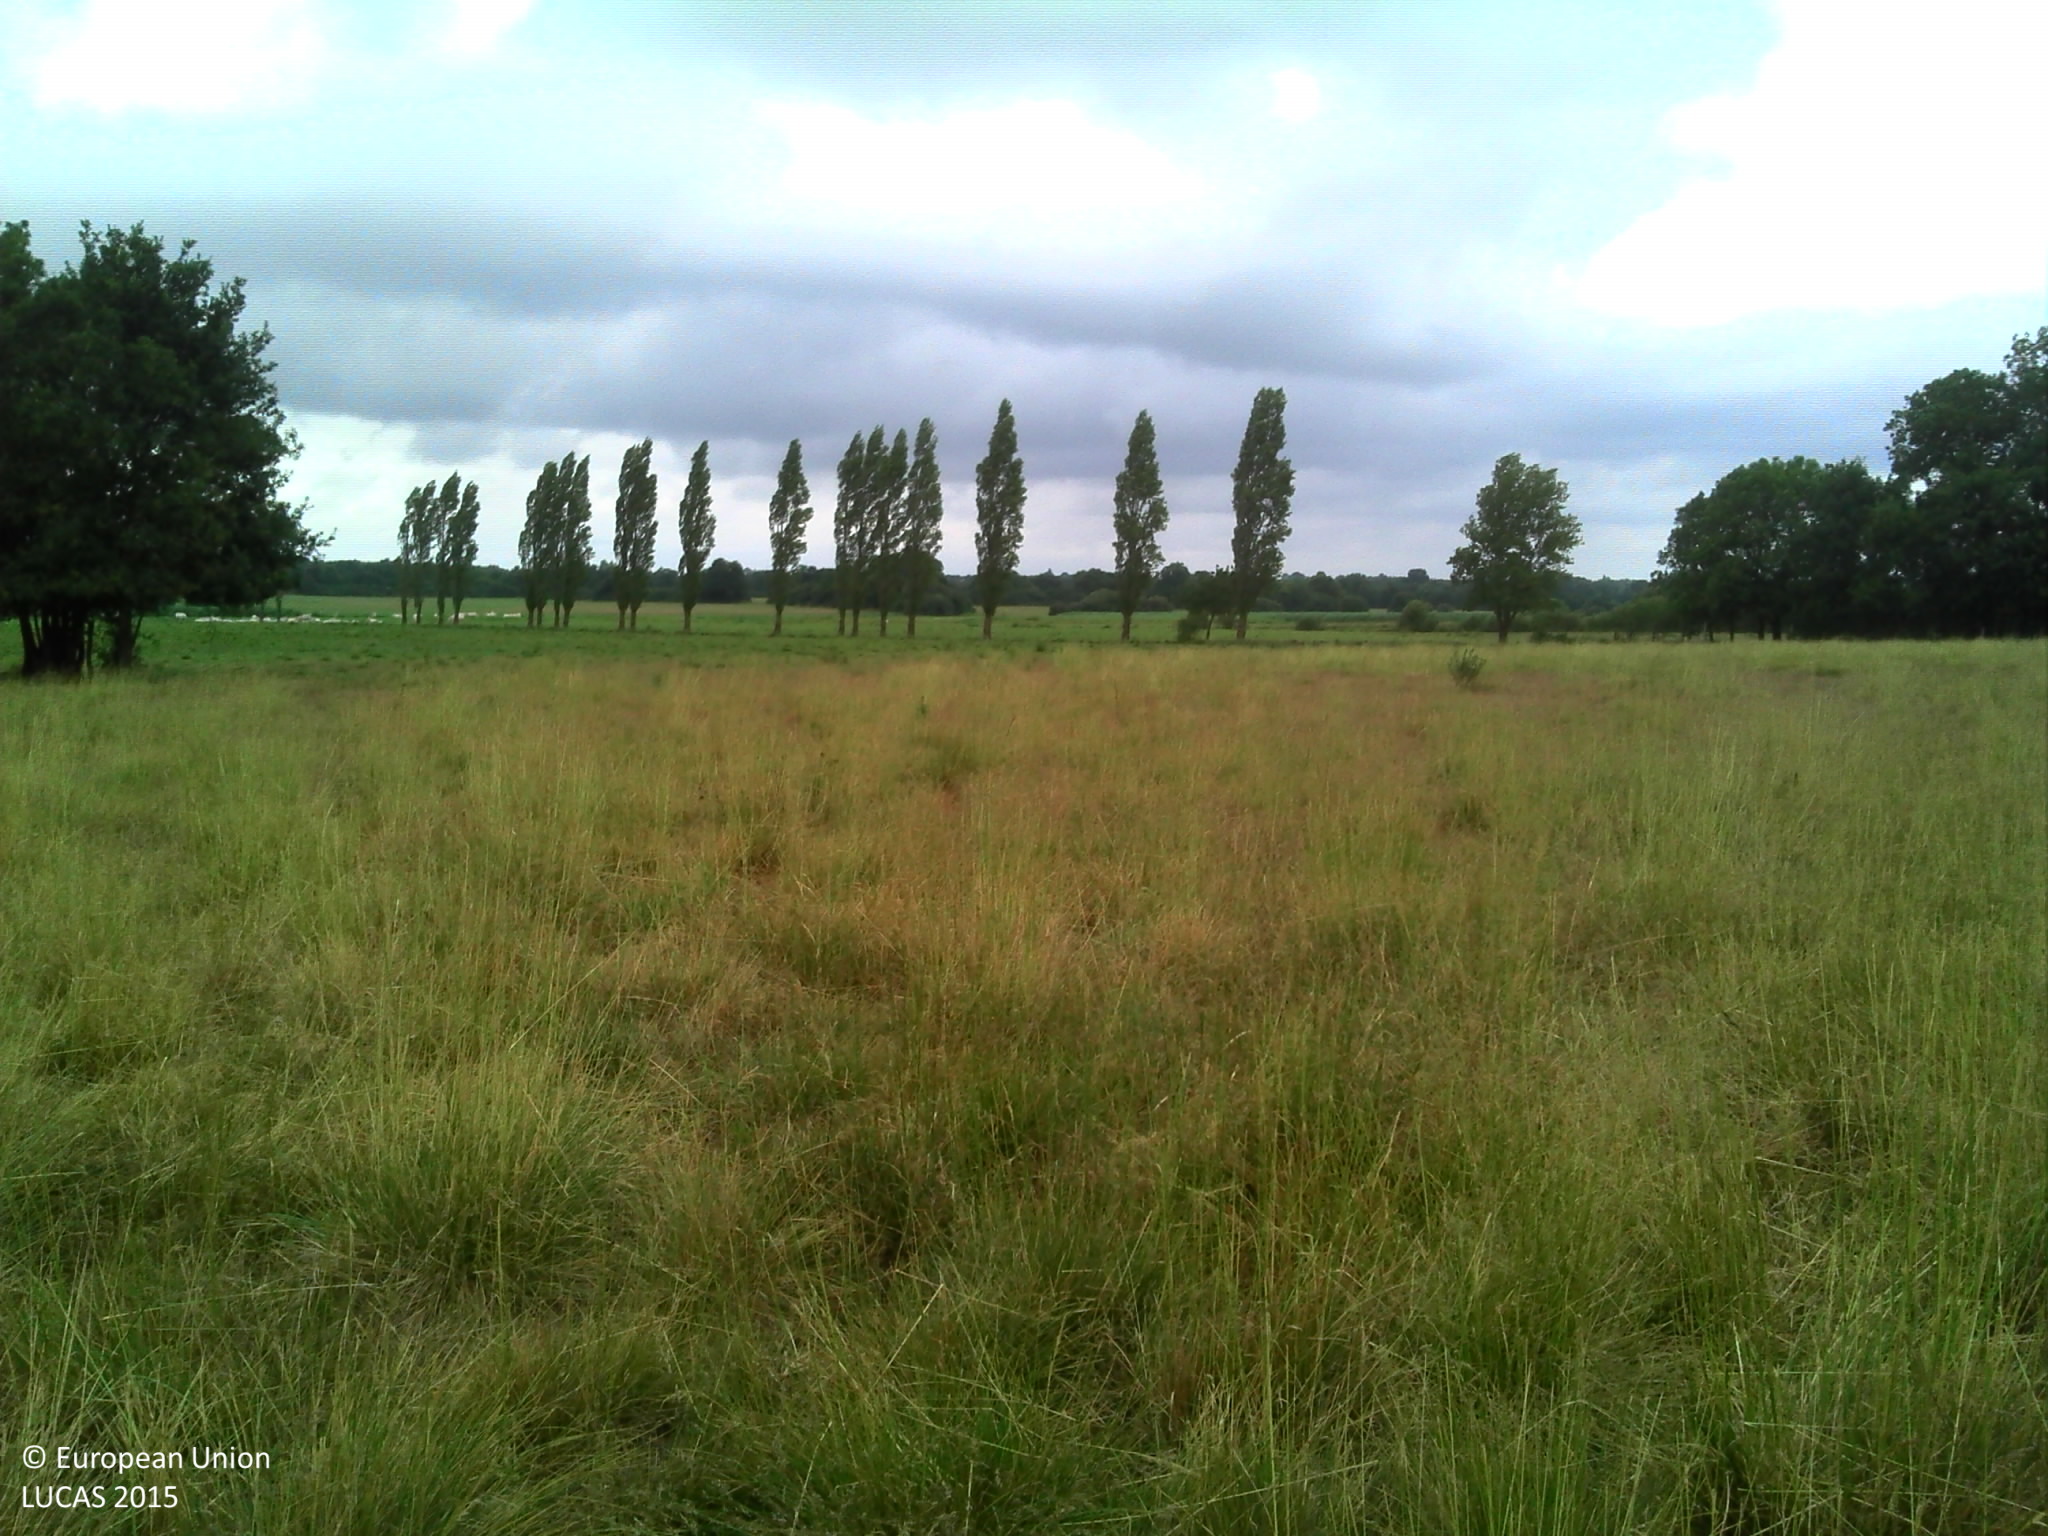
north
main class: Grassland
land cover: Grassland without tree/shrub cover
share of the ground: > 75 %
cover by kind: herbaceous plants 100 %
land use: Agriculture (excluding fallow land and kitchen gardens)
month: July
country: FR
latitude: 47.1009
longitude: -1.7576
